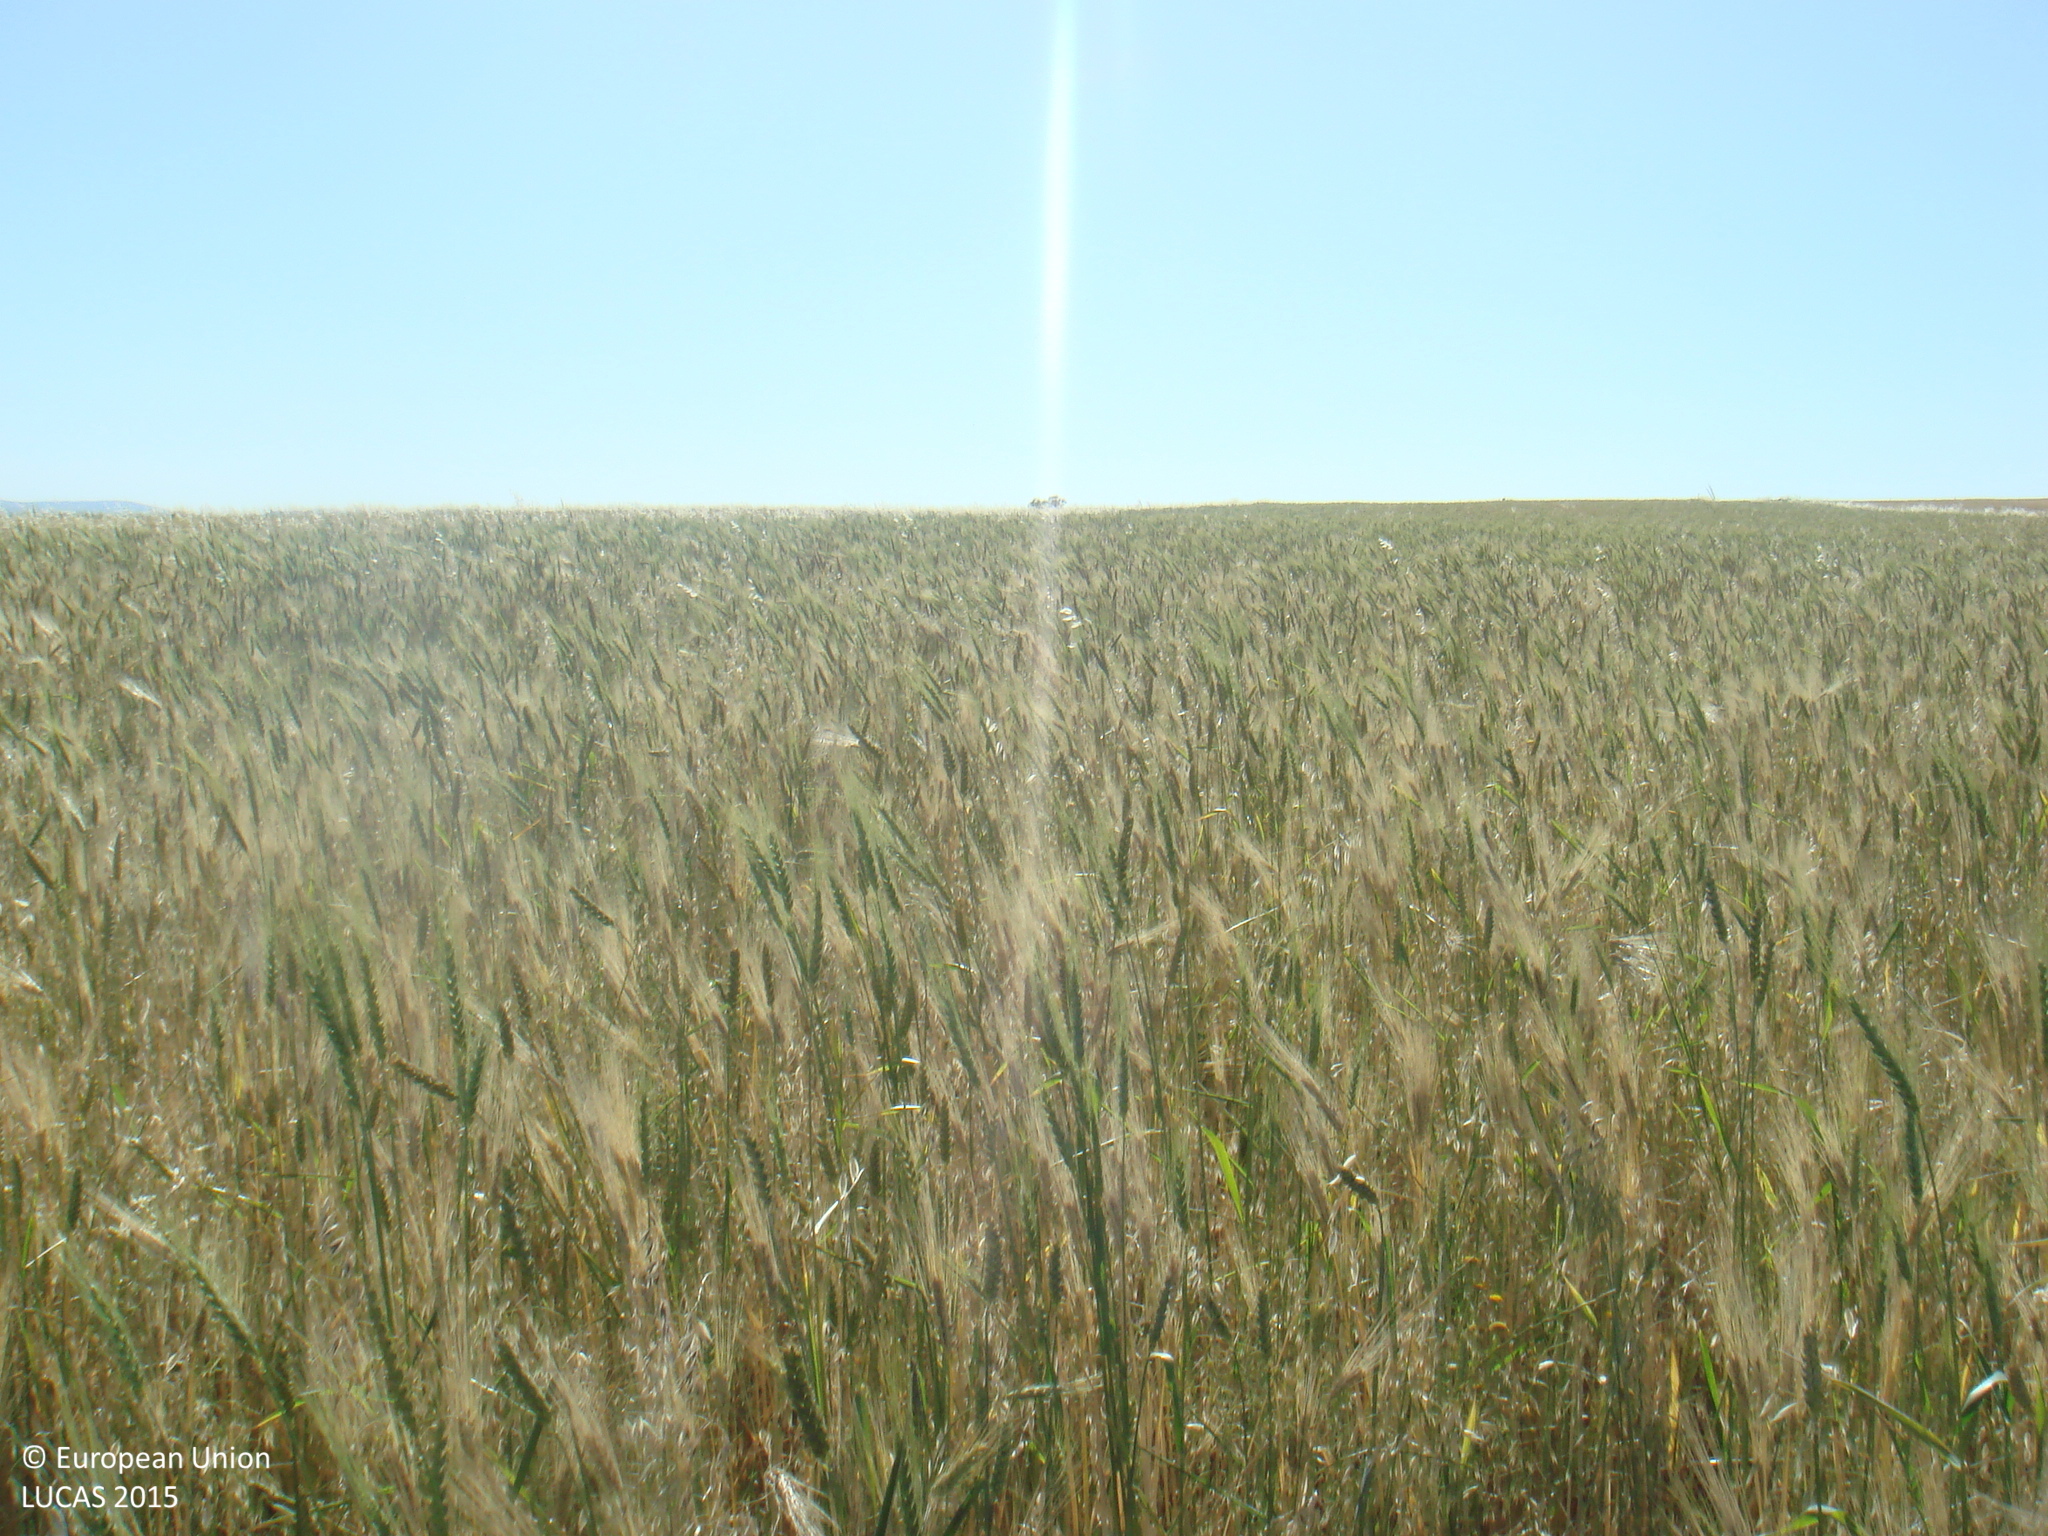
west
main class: Cropland
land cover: Mixed cereals for fodder
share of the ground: > 75 %
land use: Agriculture (excluding fallow land and kitchen gardens)
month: May
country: ES
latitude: 38.5372
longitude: -5.1160
